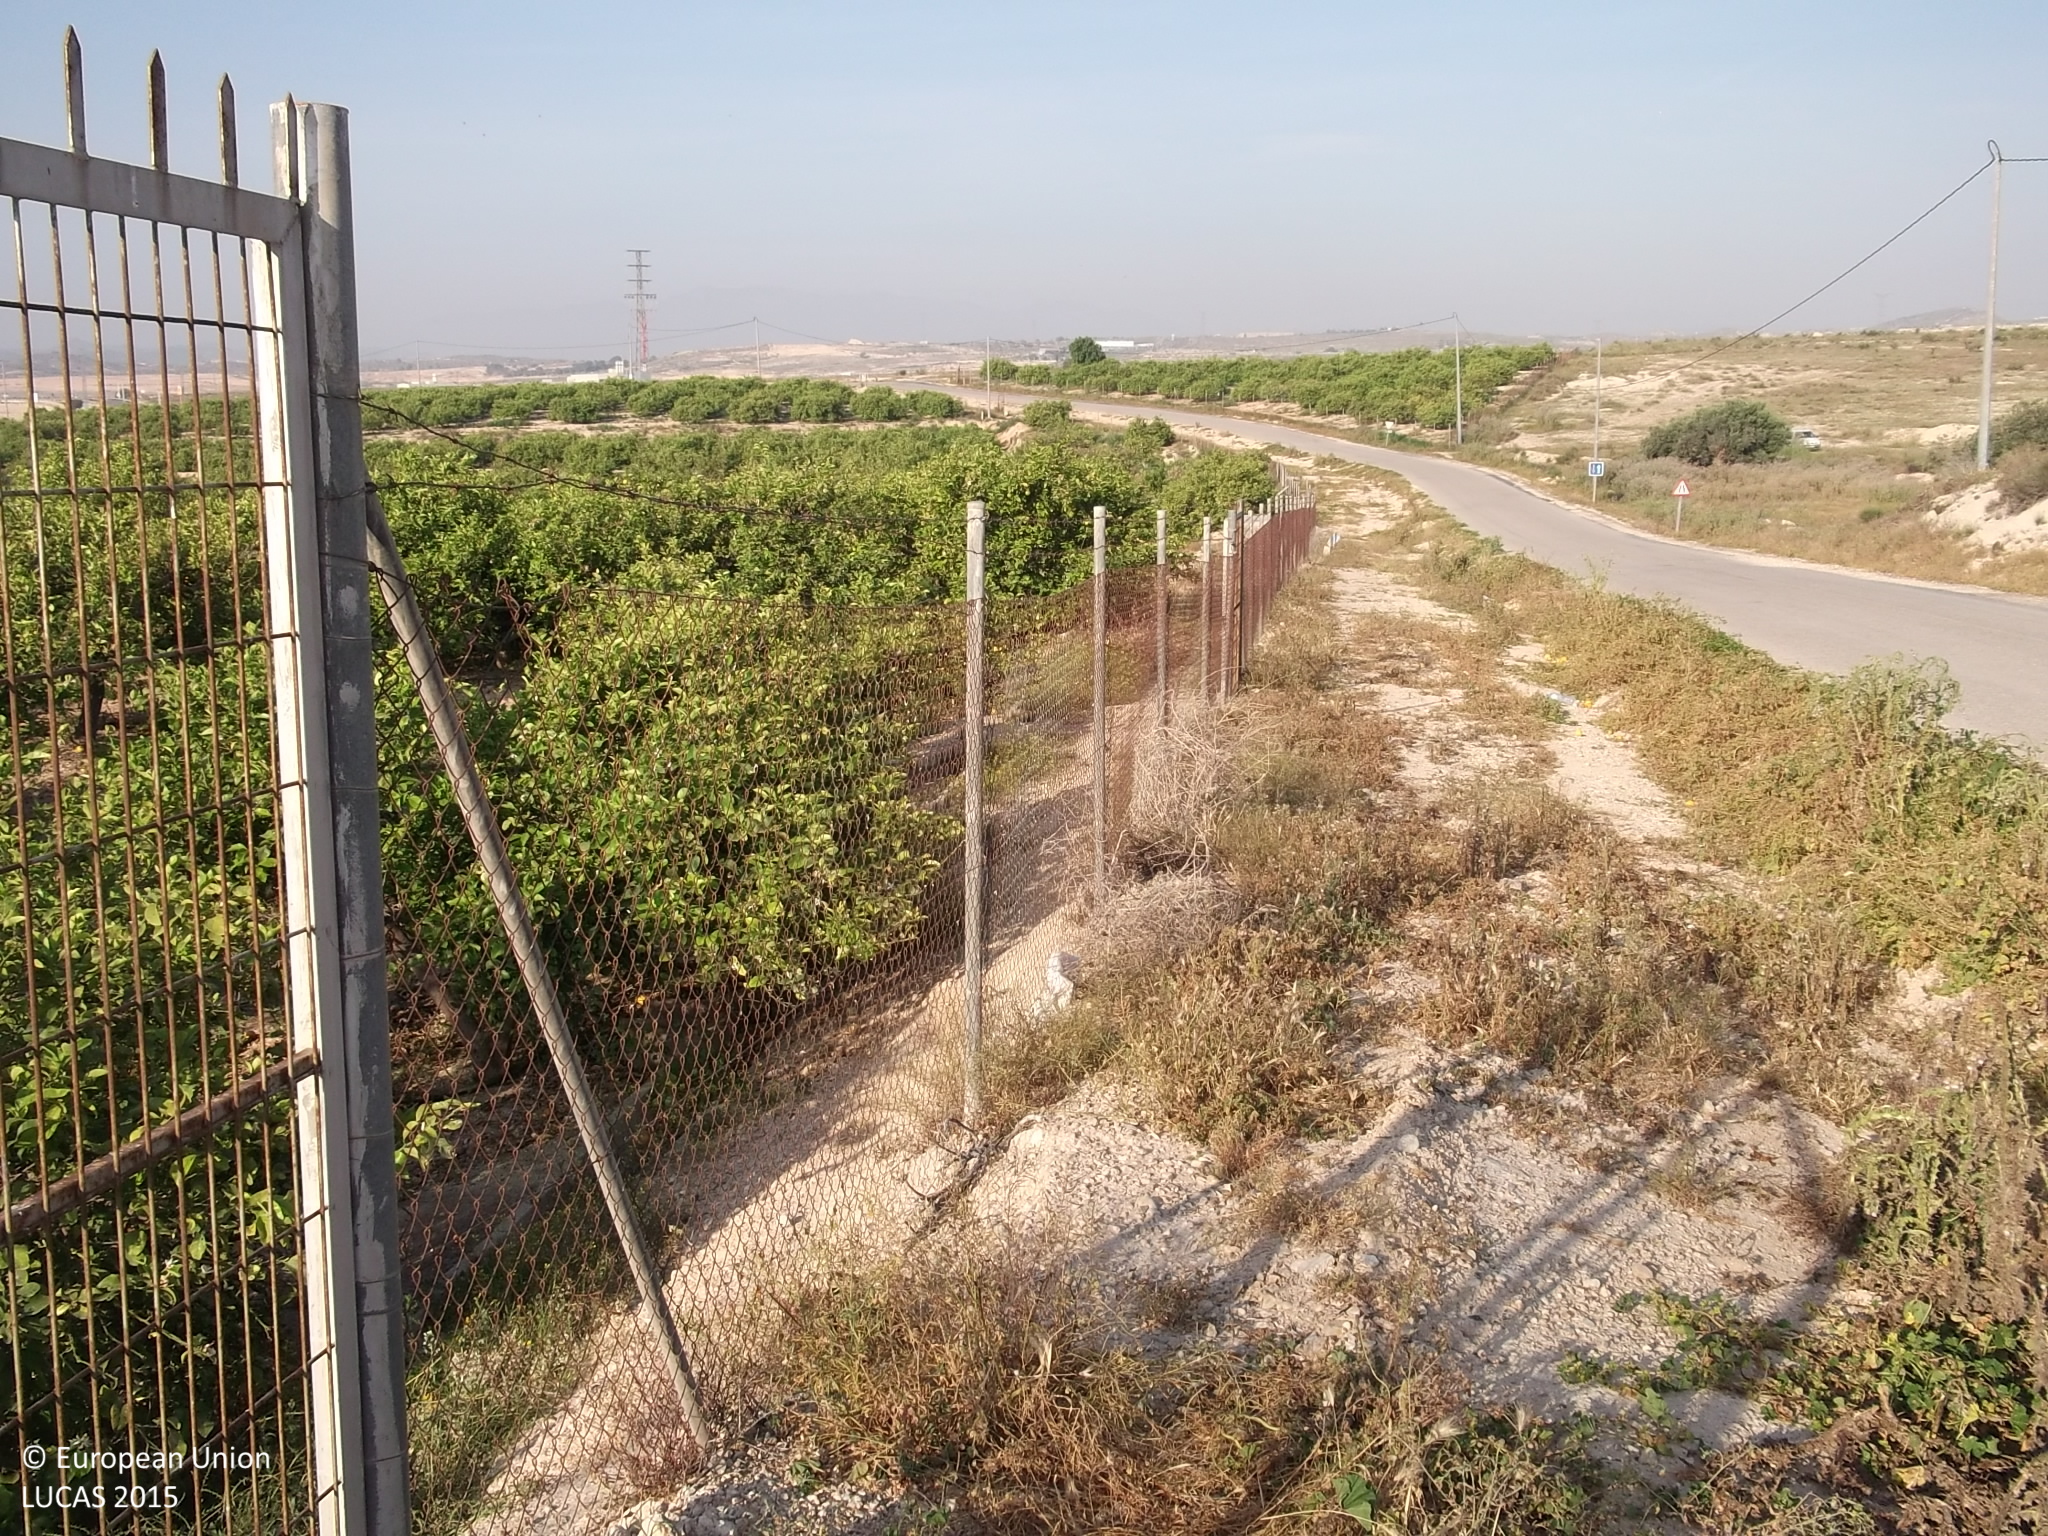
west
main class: Cropland
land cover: Other citrus fruit
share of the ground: 25 - 50 %
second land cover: Other bare soil
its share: > 75 %
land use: Agriculture (excluding fallow land and kitchen gardens)
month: April
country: ES
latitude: 38.0232
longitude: -1.2969
